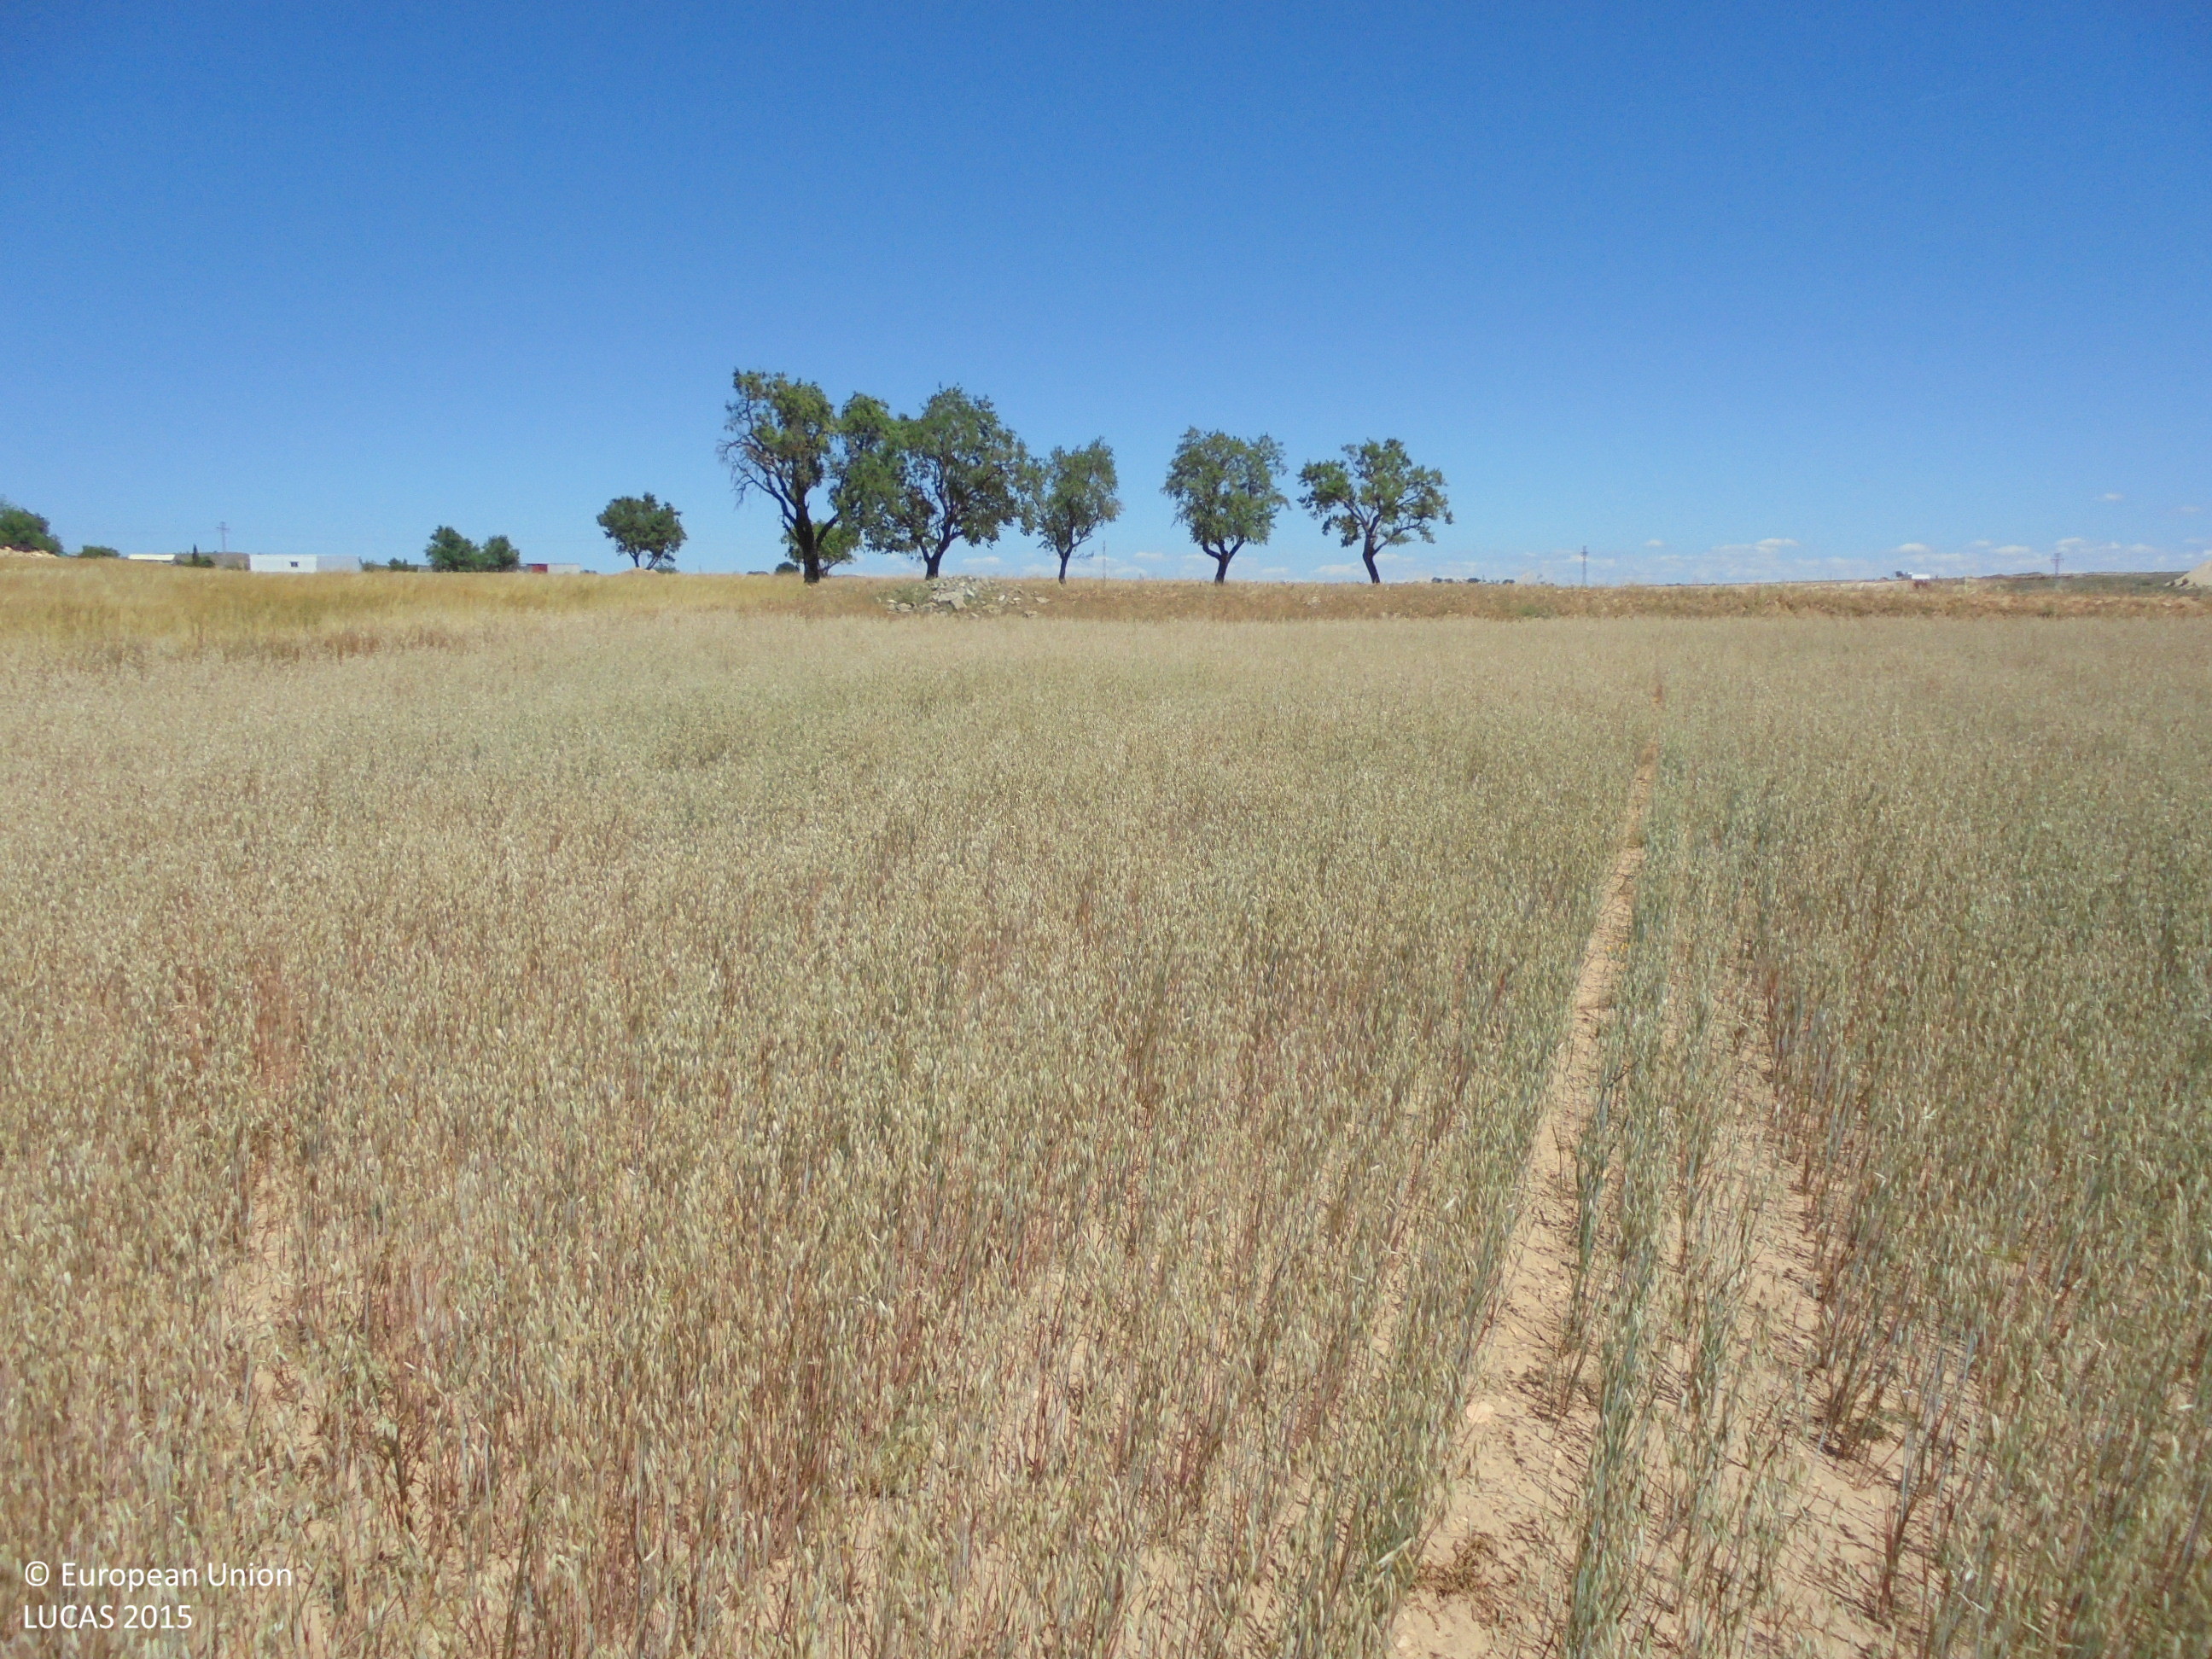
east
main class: Cropland
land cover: Oats
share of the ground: 25 - 50 %
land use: Agriculture (excluding fallow land and kitchen gardens)
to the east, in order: Oats; Grassland without tree/shrub cover; Spontaneously vegetated surfaces; Groves; Spontaneously vegetated surfaces; Grass margins; Tracks; Grass margins; Oats; Grass margins; Oats
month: May
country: ES
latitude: 38.9038
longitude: -1.7255
